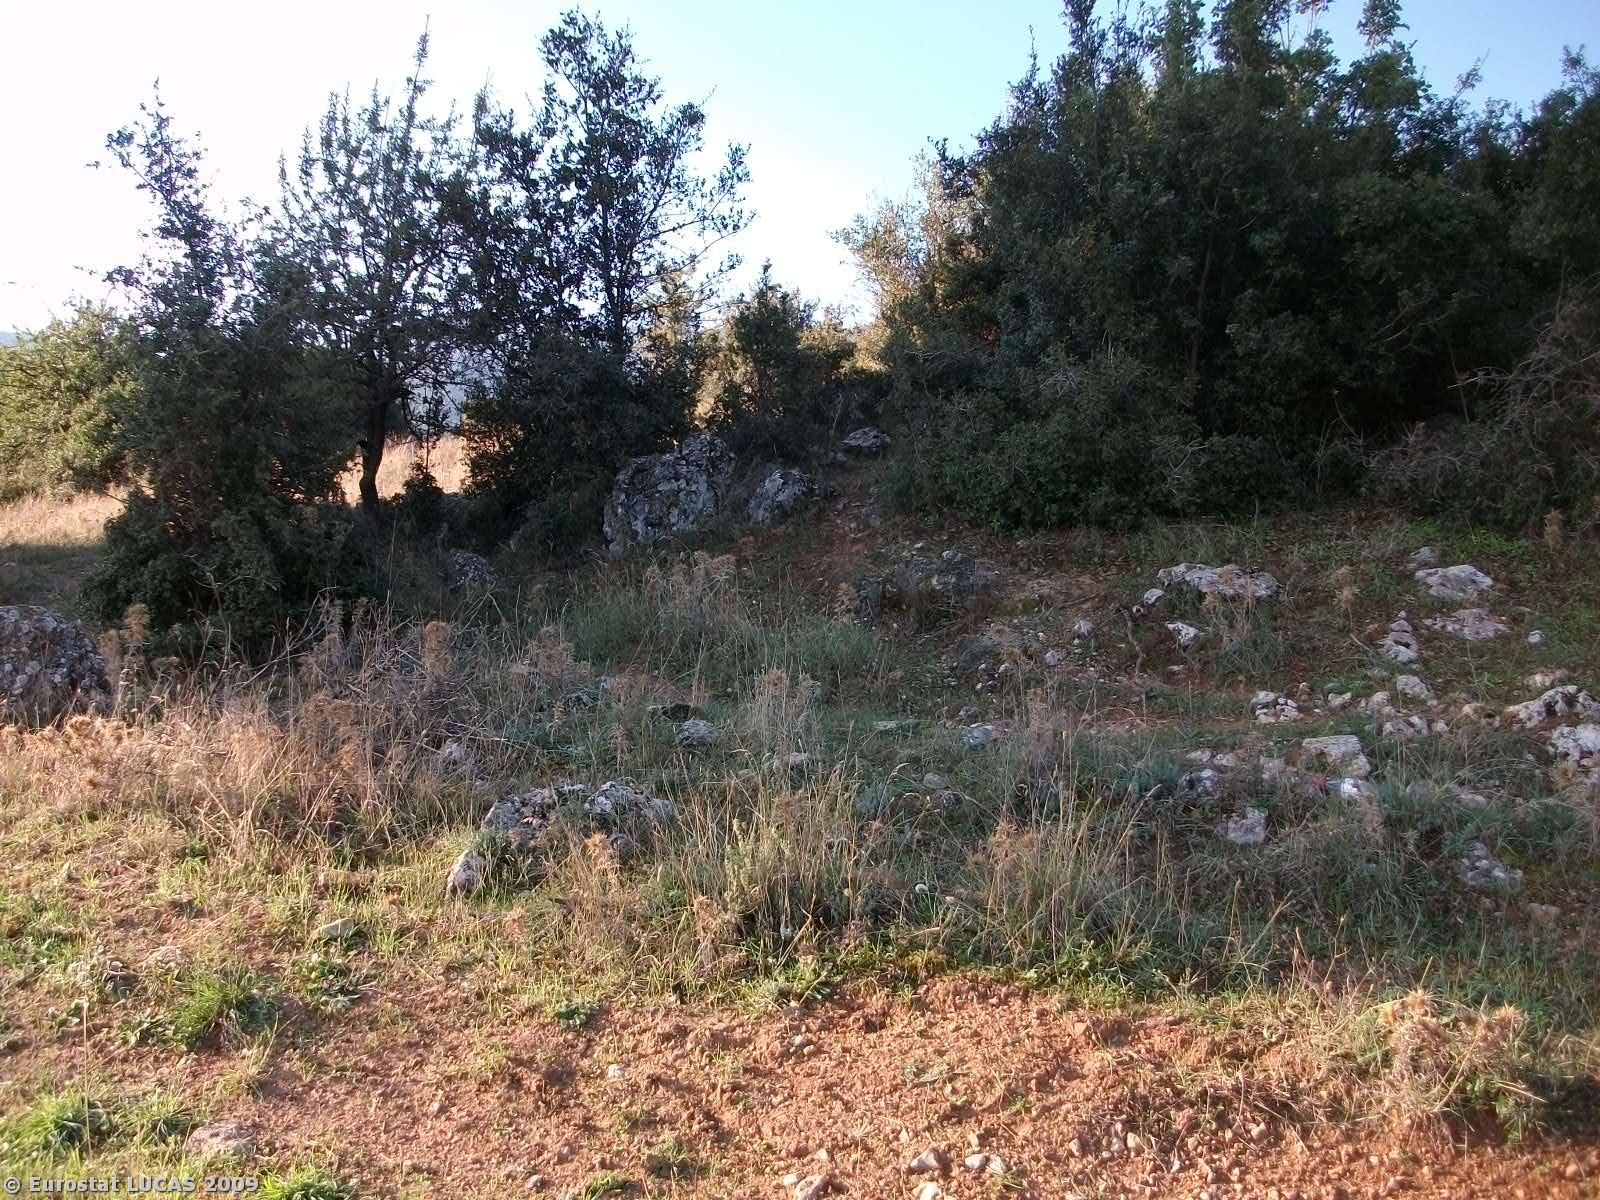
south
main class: Grassland
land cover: Grassland with sparse tree/shrub cover
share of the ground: > 75 %
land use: Agriculture (excluding fallow land and kitchen gardens)
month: September
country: GR
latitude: 38.2516
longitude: 23.7314
